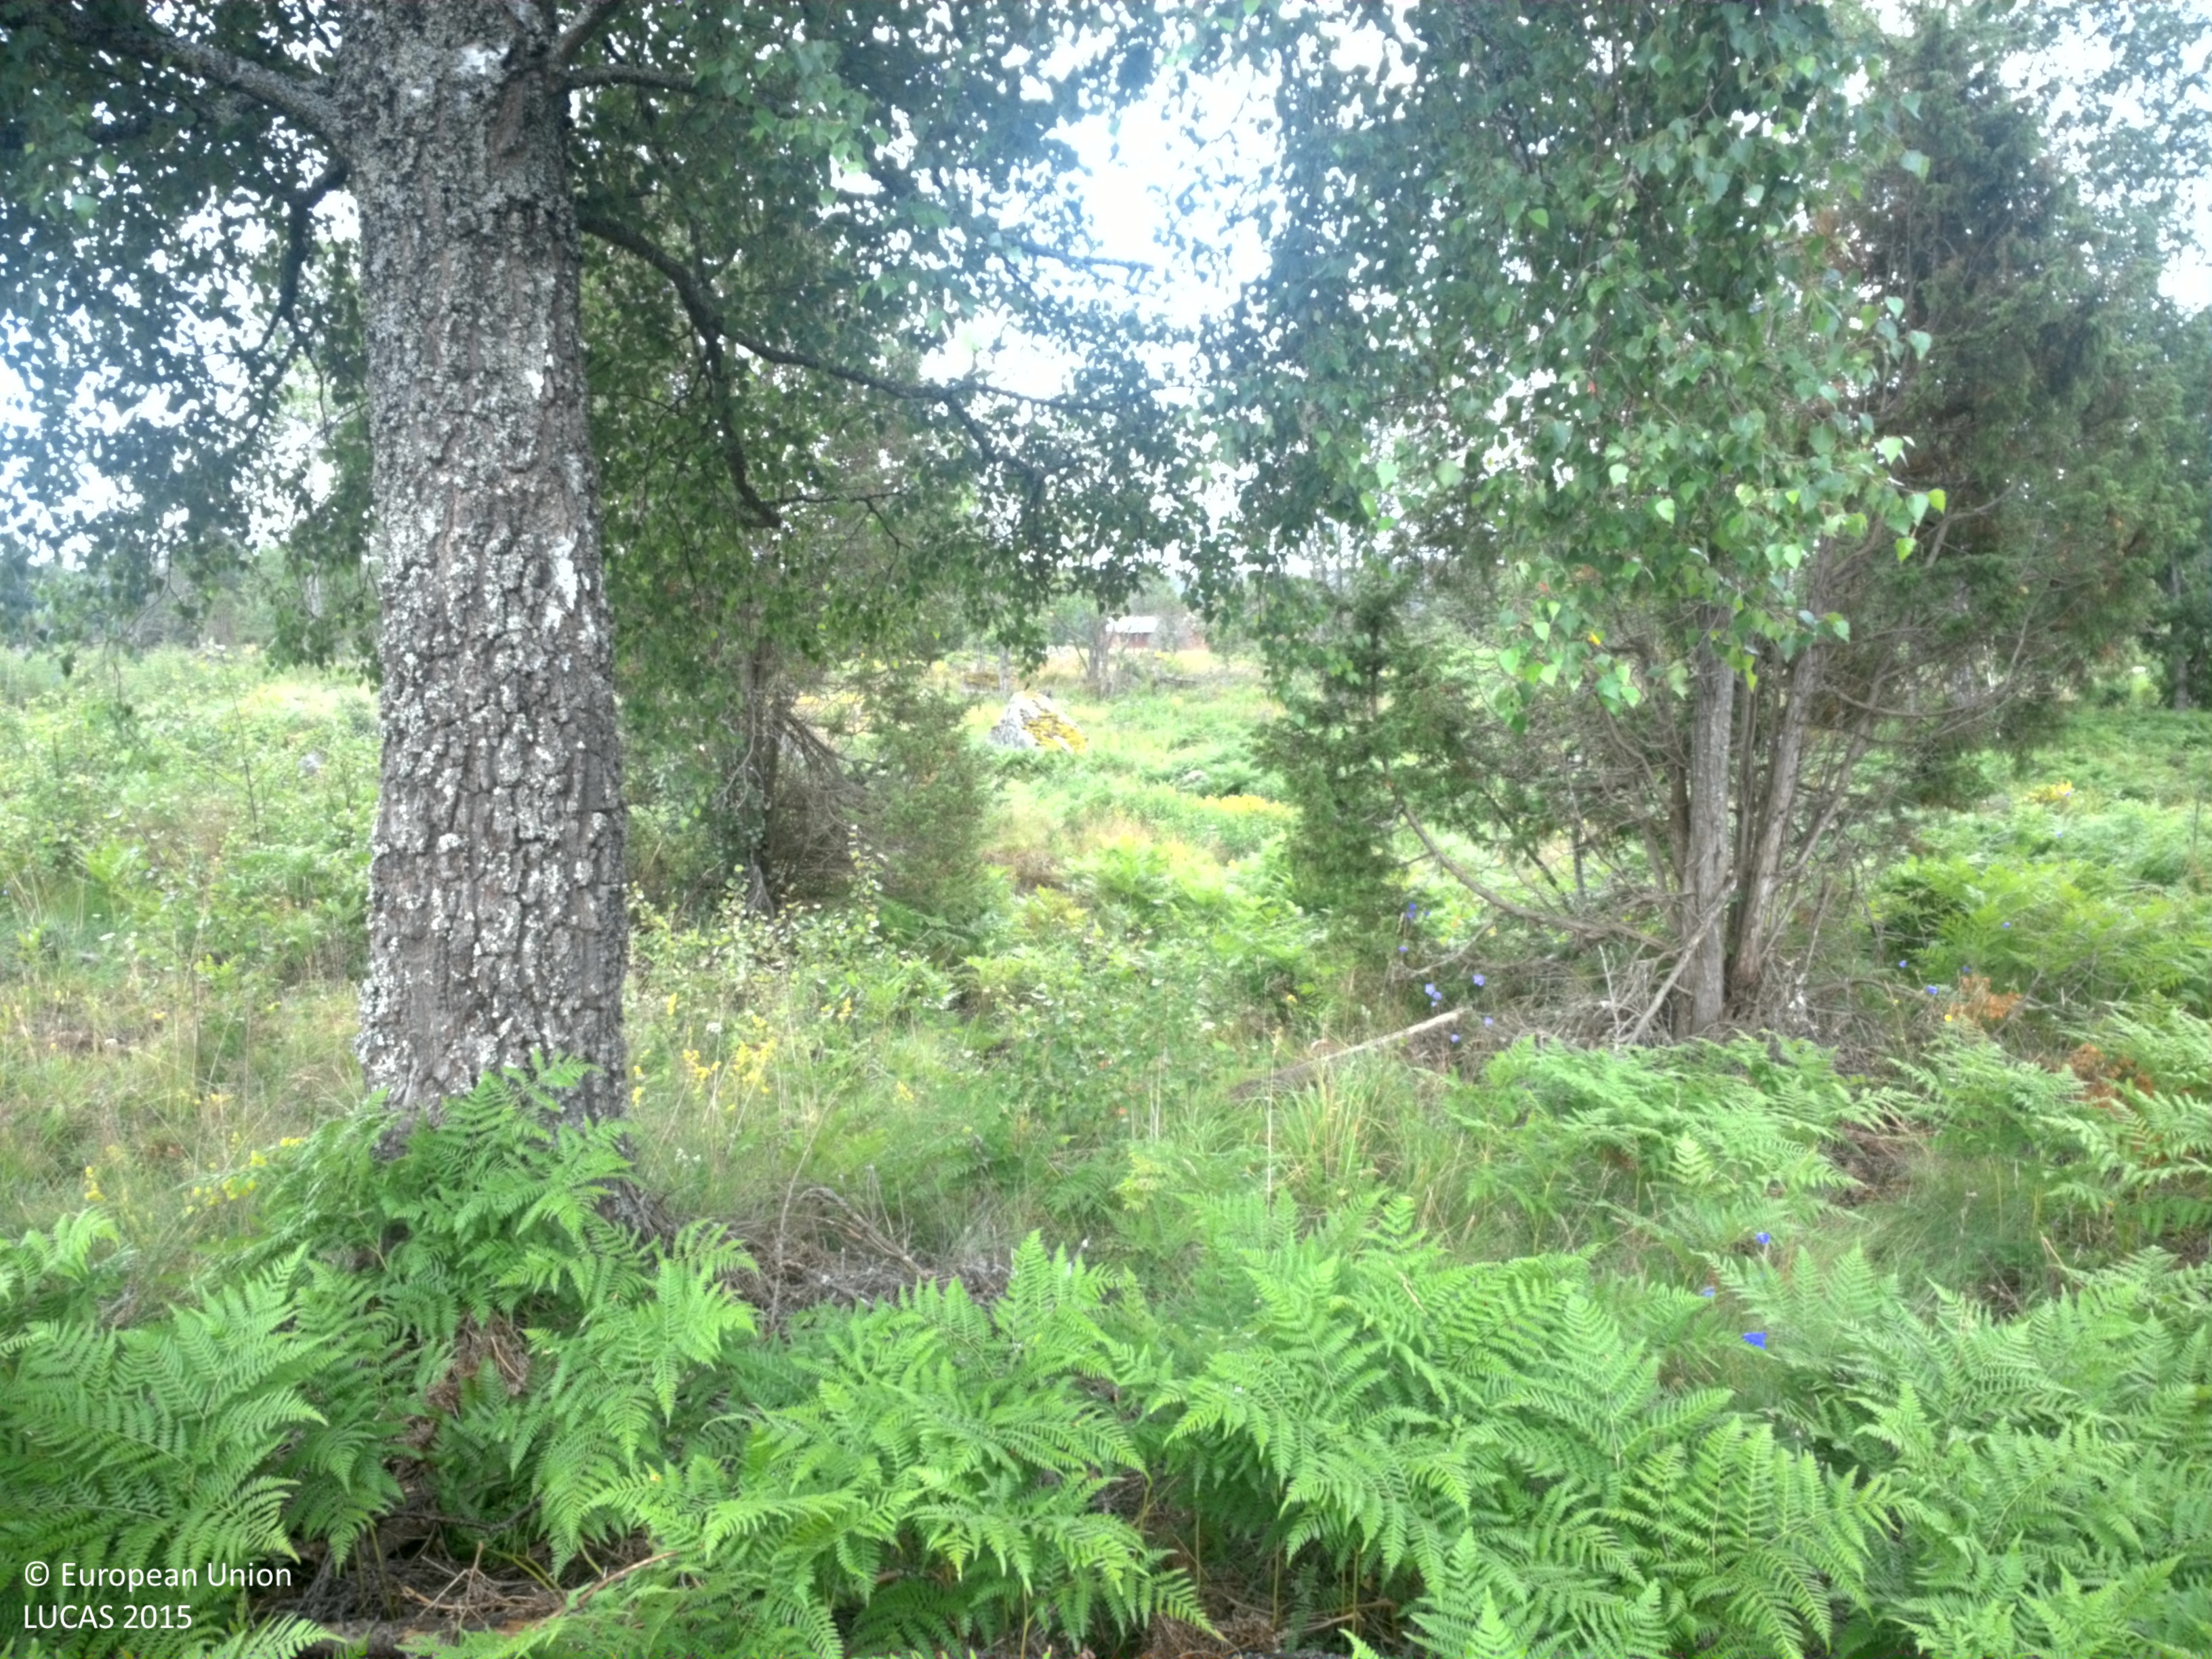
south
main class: Woodland
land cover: Broadleaved woodland
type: hemiboreal forest and nemoral coniferous forest and mixed broadleaved-coniferous forest
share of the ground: 10 - 25 %
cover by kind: herbaceous plants 85 %, broadleaved forest trees 15 %
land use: Forestry
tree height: < 5 m
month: July
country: SE
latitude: 59.9042
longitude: 18.5263
